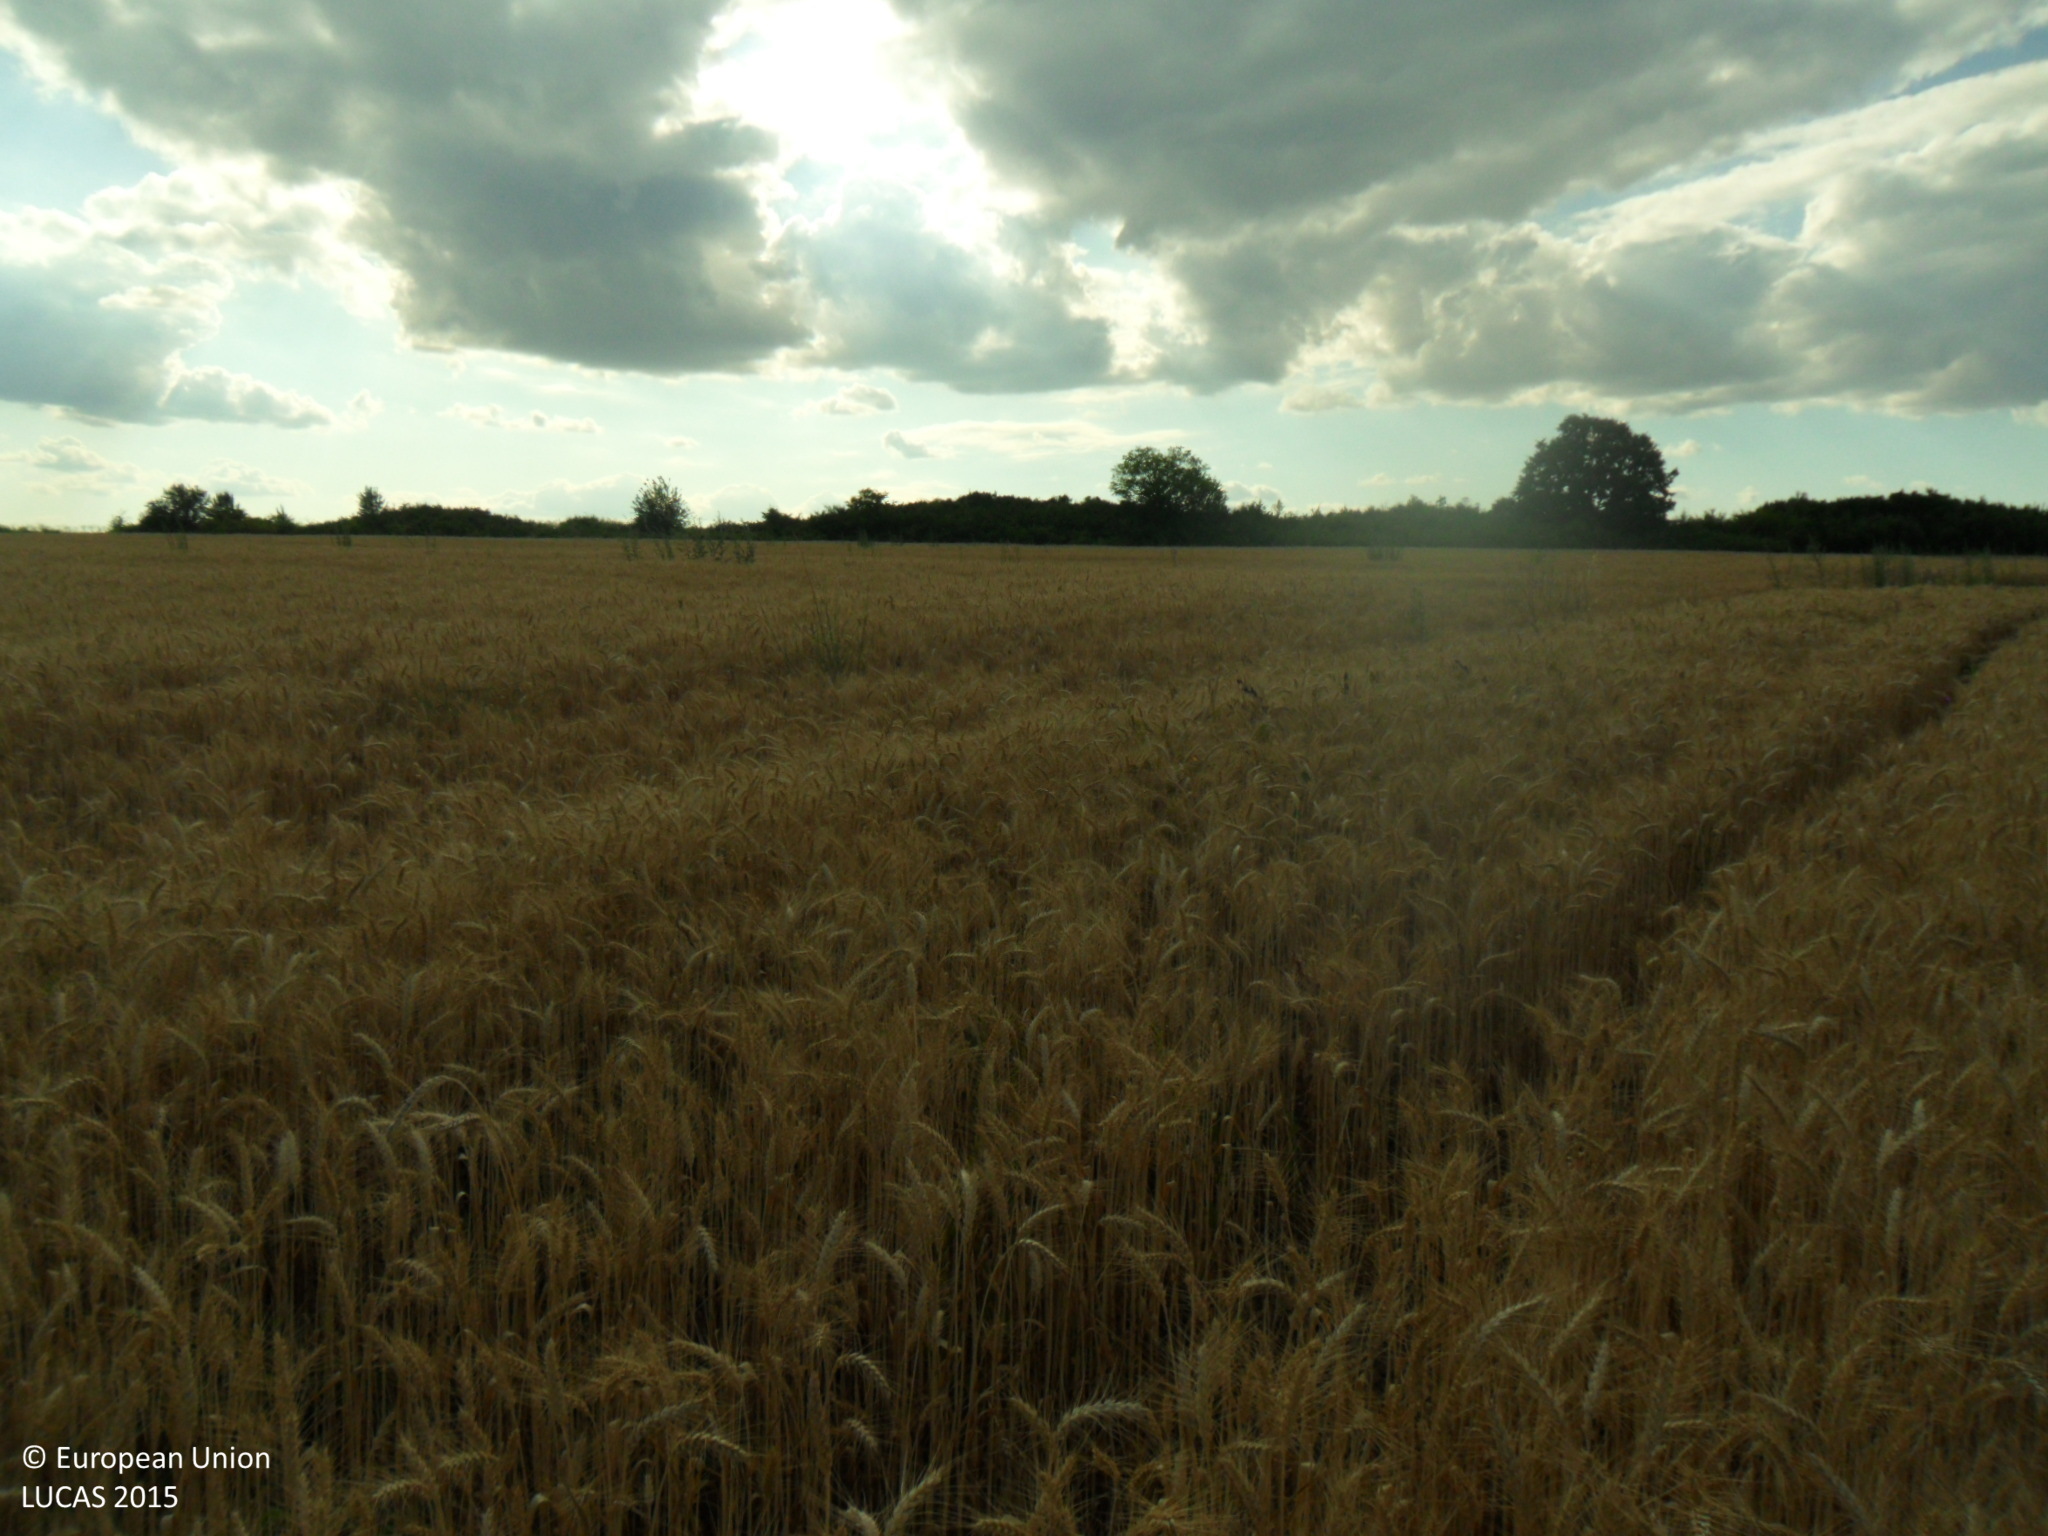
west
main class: Cropland
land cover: Common wheat
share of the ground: > 75 %
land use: Agriculture (excluding fallow land and kitchen gardens)
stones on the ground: < 10 %
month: June
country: BG
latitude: 43.5305
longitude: 27.2879
